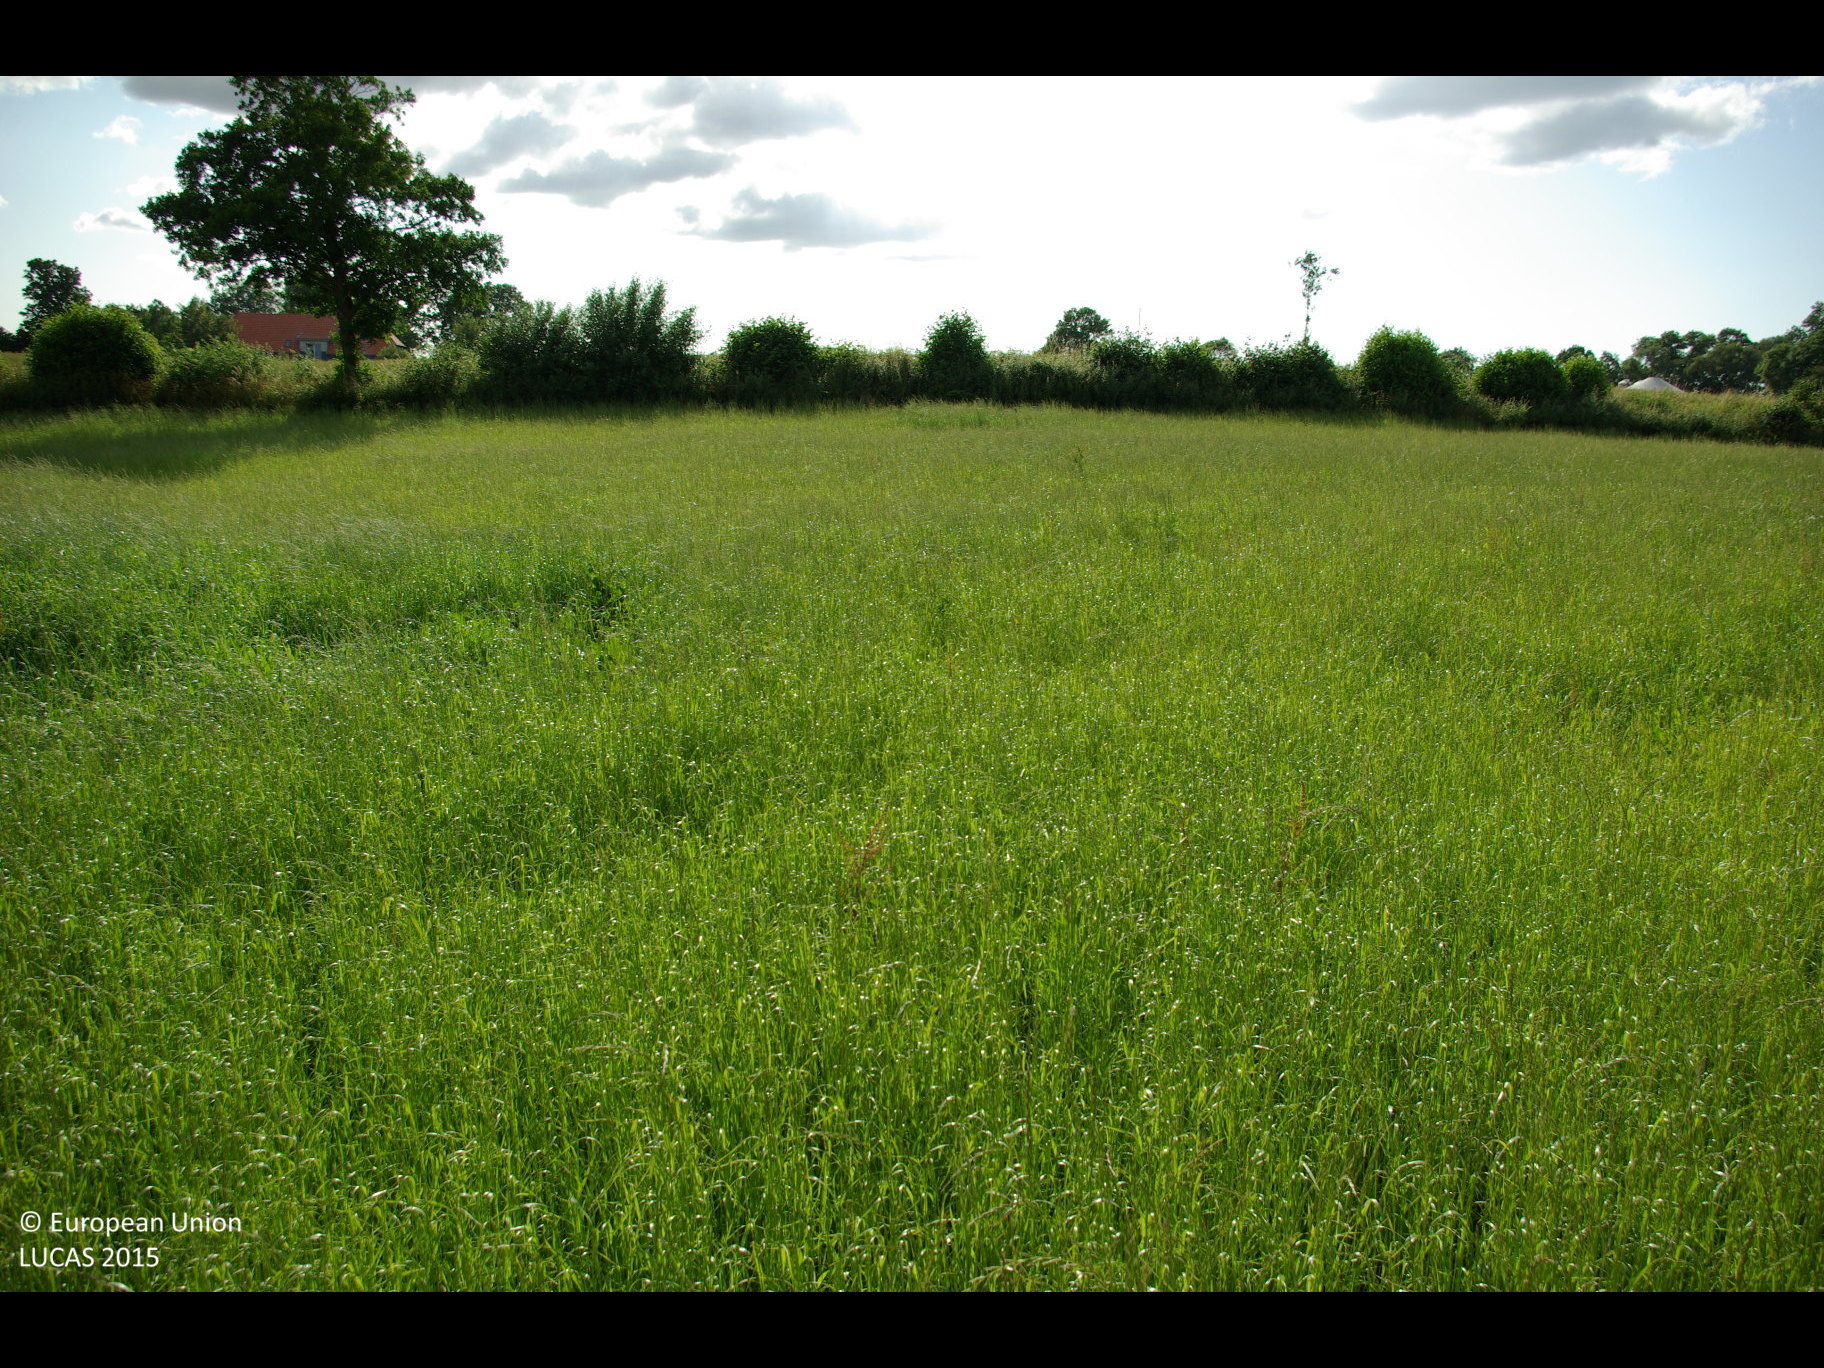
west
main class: Grassland
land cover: Grassland without tree/shrub cover
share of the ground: > 75 %
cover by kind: herbaceous plants 100 %
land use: Agriculture (excluding fallow land and kitchen gardens)
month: July
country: DE
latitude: 54.7850
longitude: 9.5494
